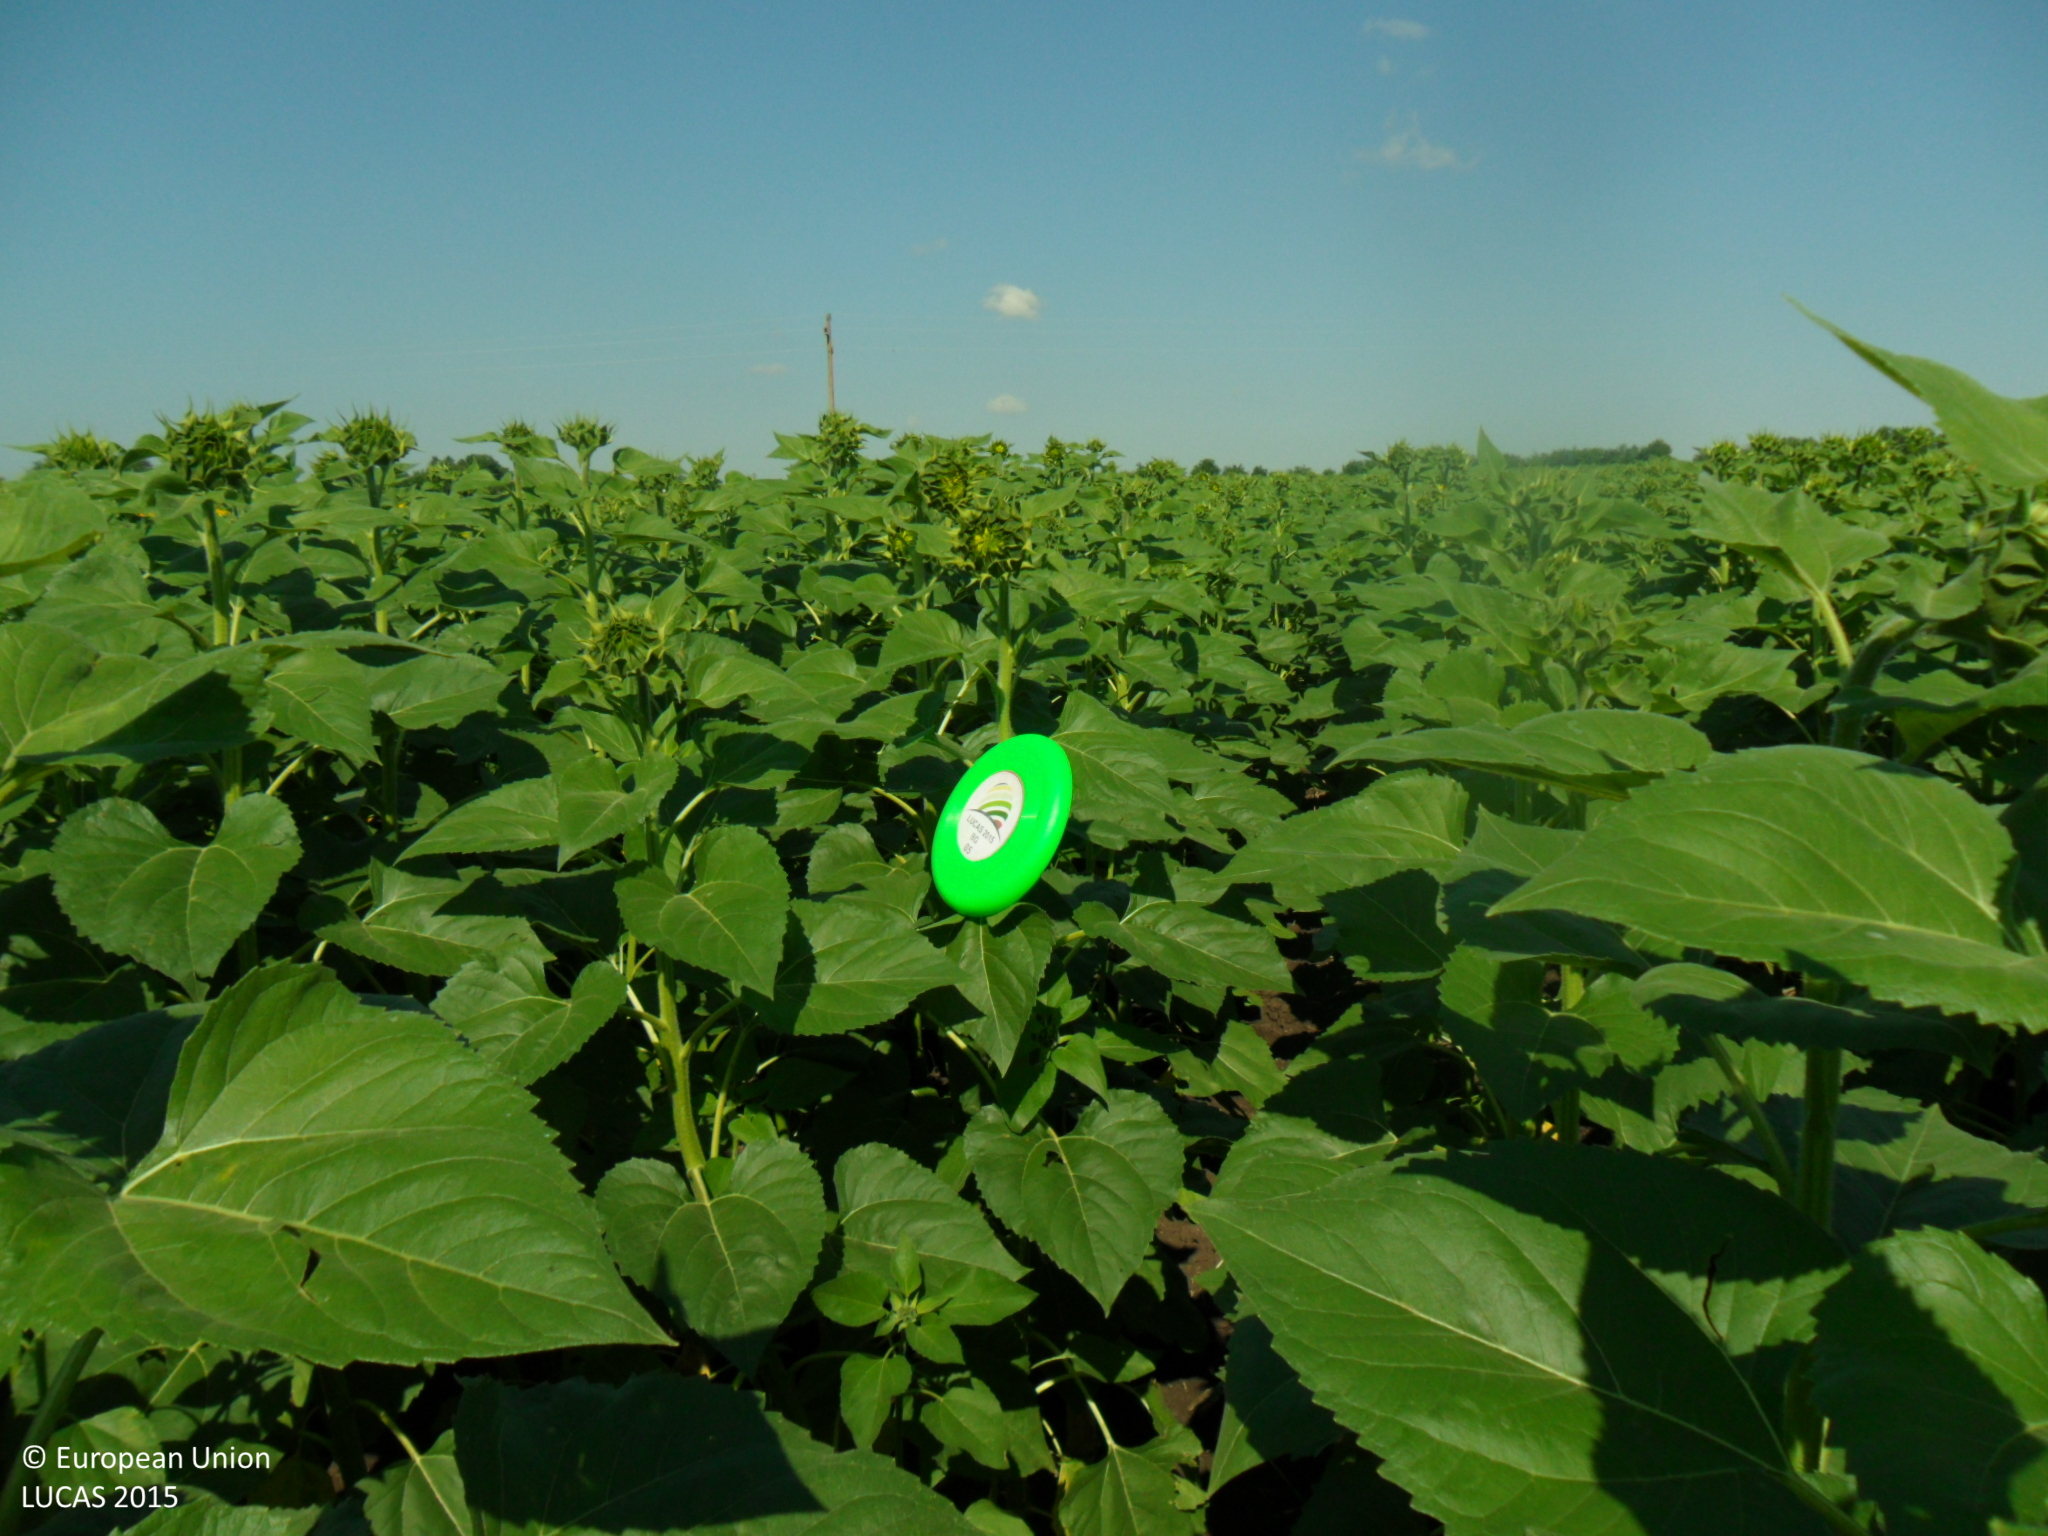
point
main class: Cropland
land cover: Sunflower
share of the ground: > 75 %
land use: Agriculture (excluding fallow land and kitchen gardens)
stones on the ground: < 10 %
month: June
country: BG
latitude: 43.3357
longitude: 27.0261
